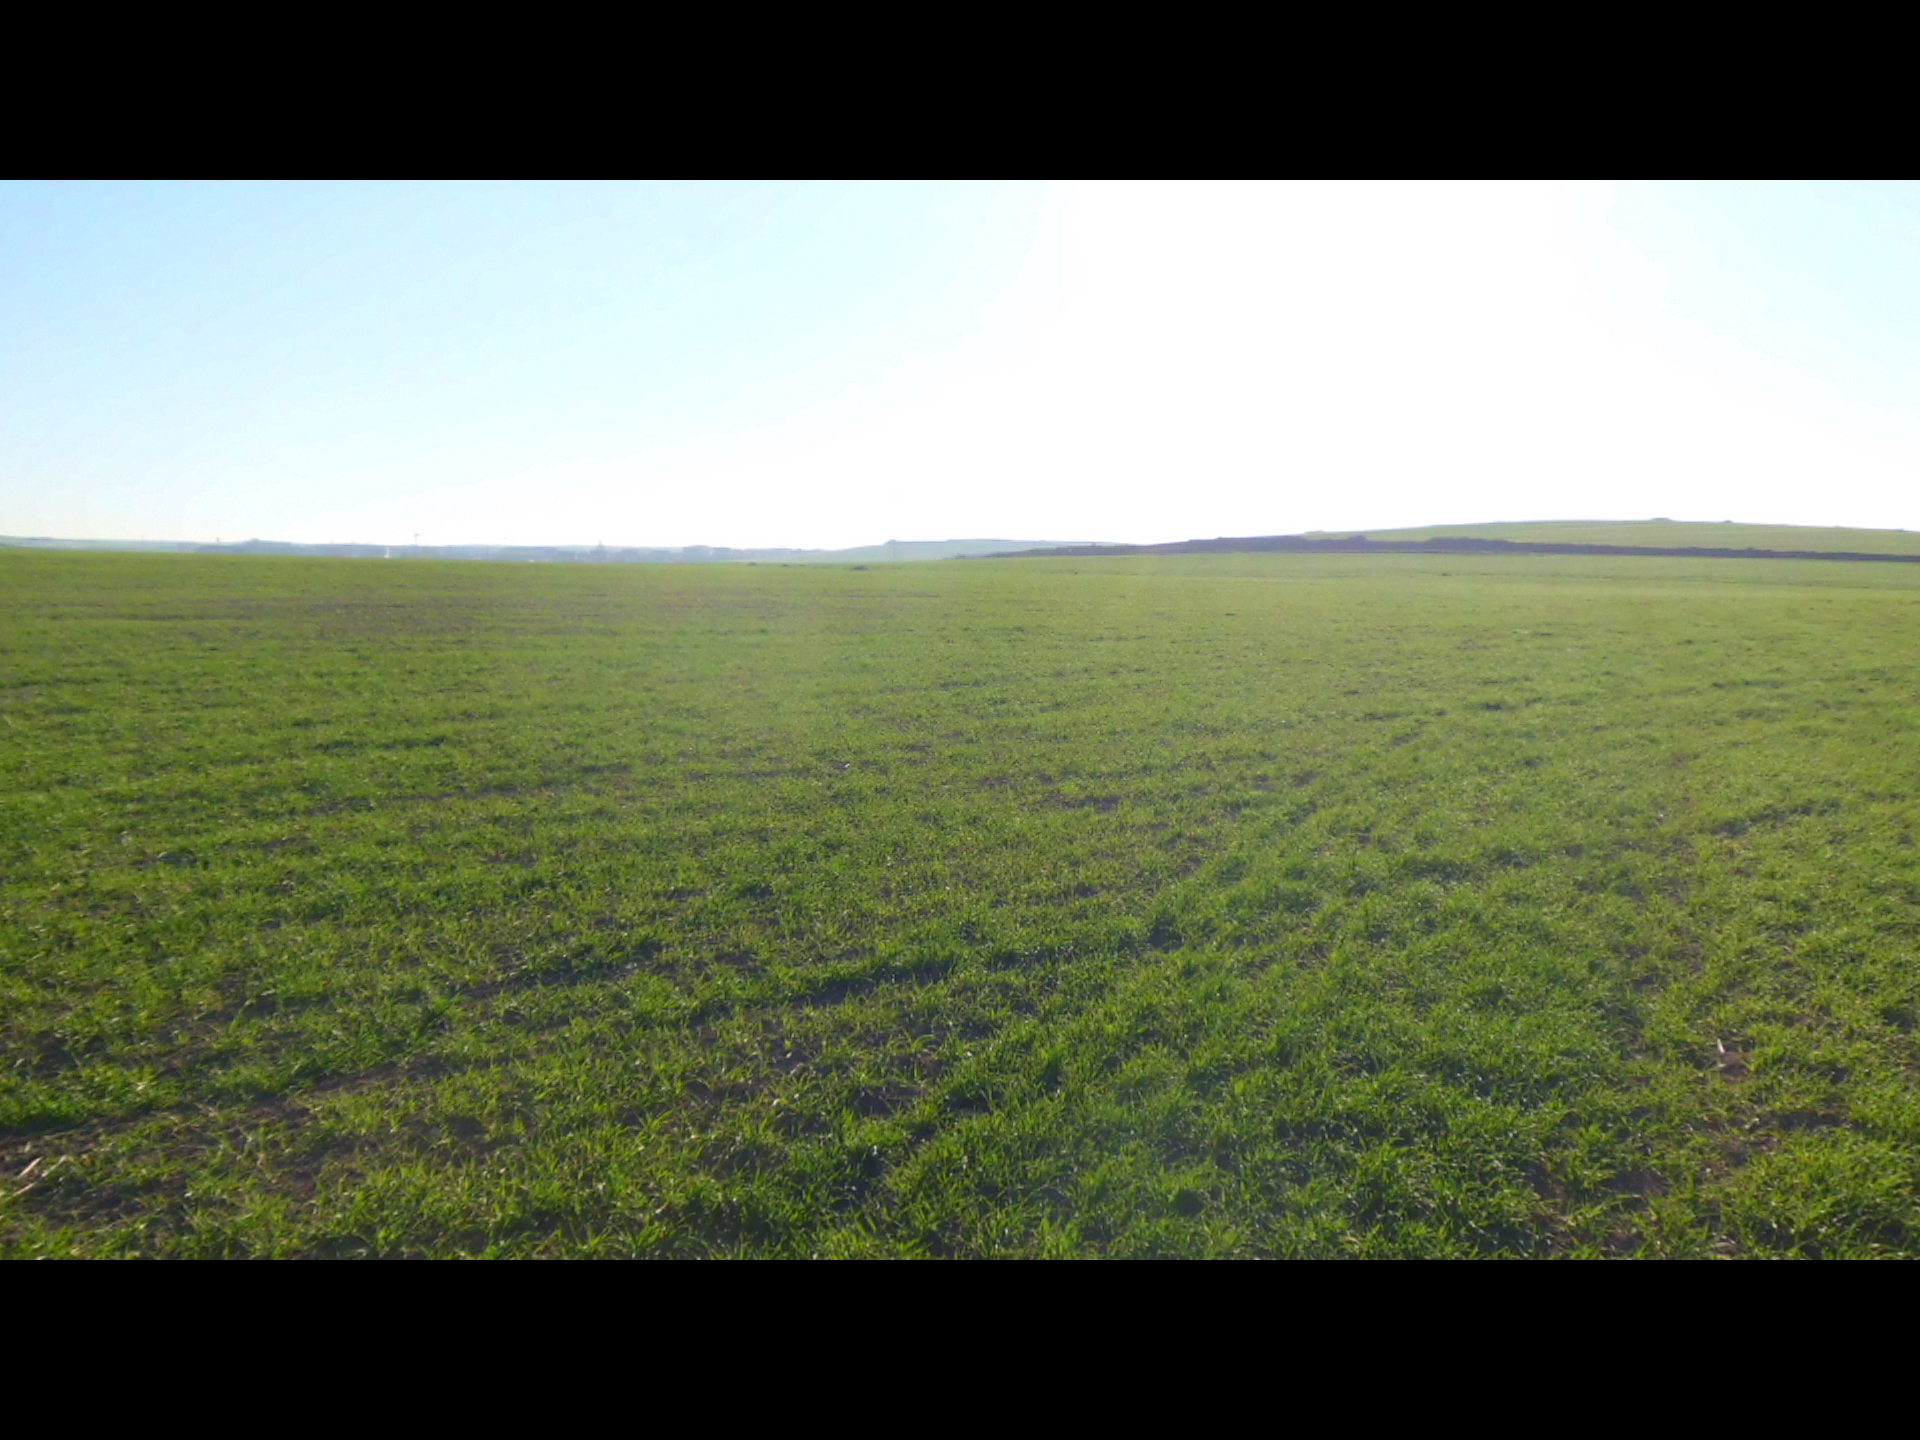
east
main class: Cropland
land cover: Barley
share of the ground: > 75 %
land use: Agriculture (excluding fallow land and kitchen gardens)
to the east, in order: Barley; Paved roads, cycling and walking lanes; Grass margins; Common wheat
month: April
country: ES
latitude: 42.2960
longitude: -3.7547
